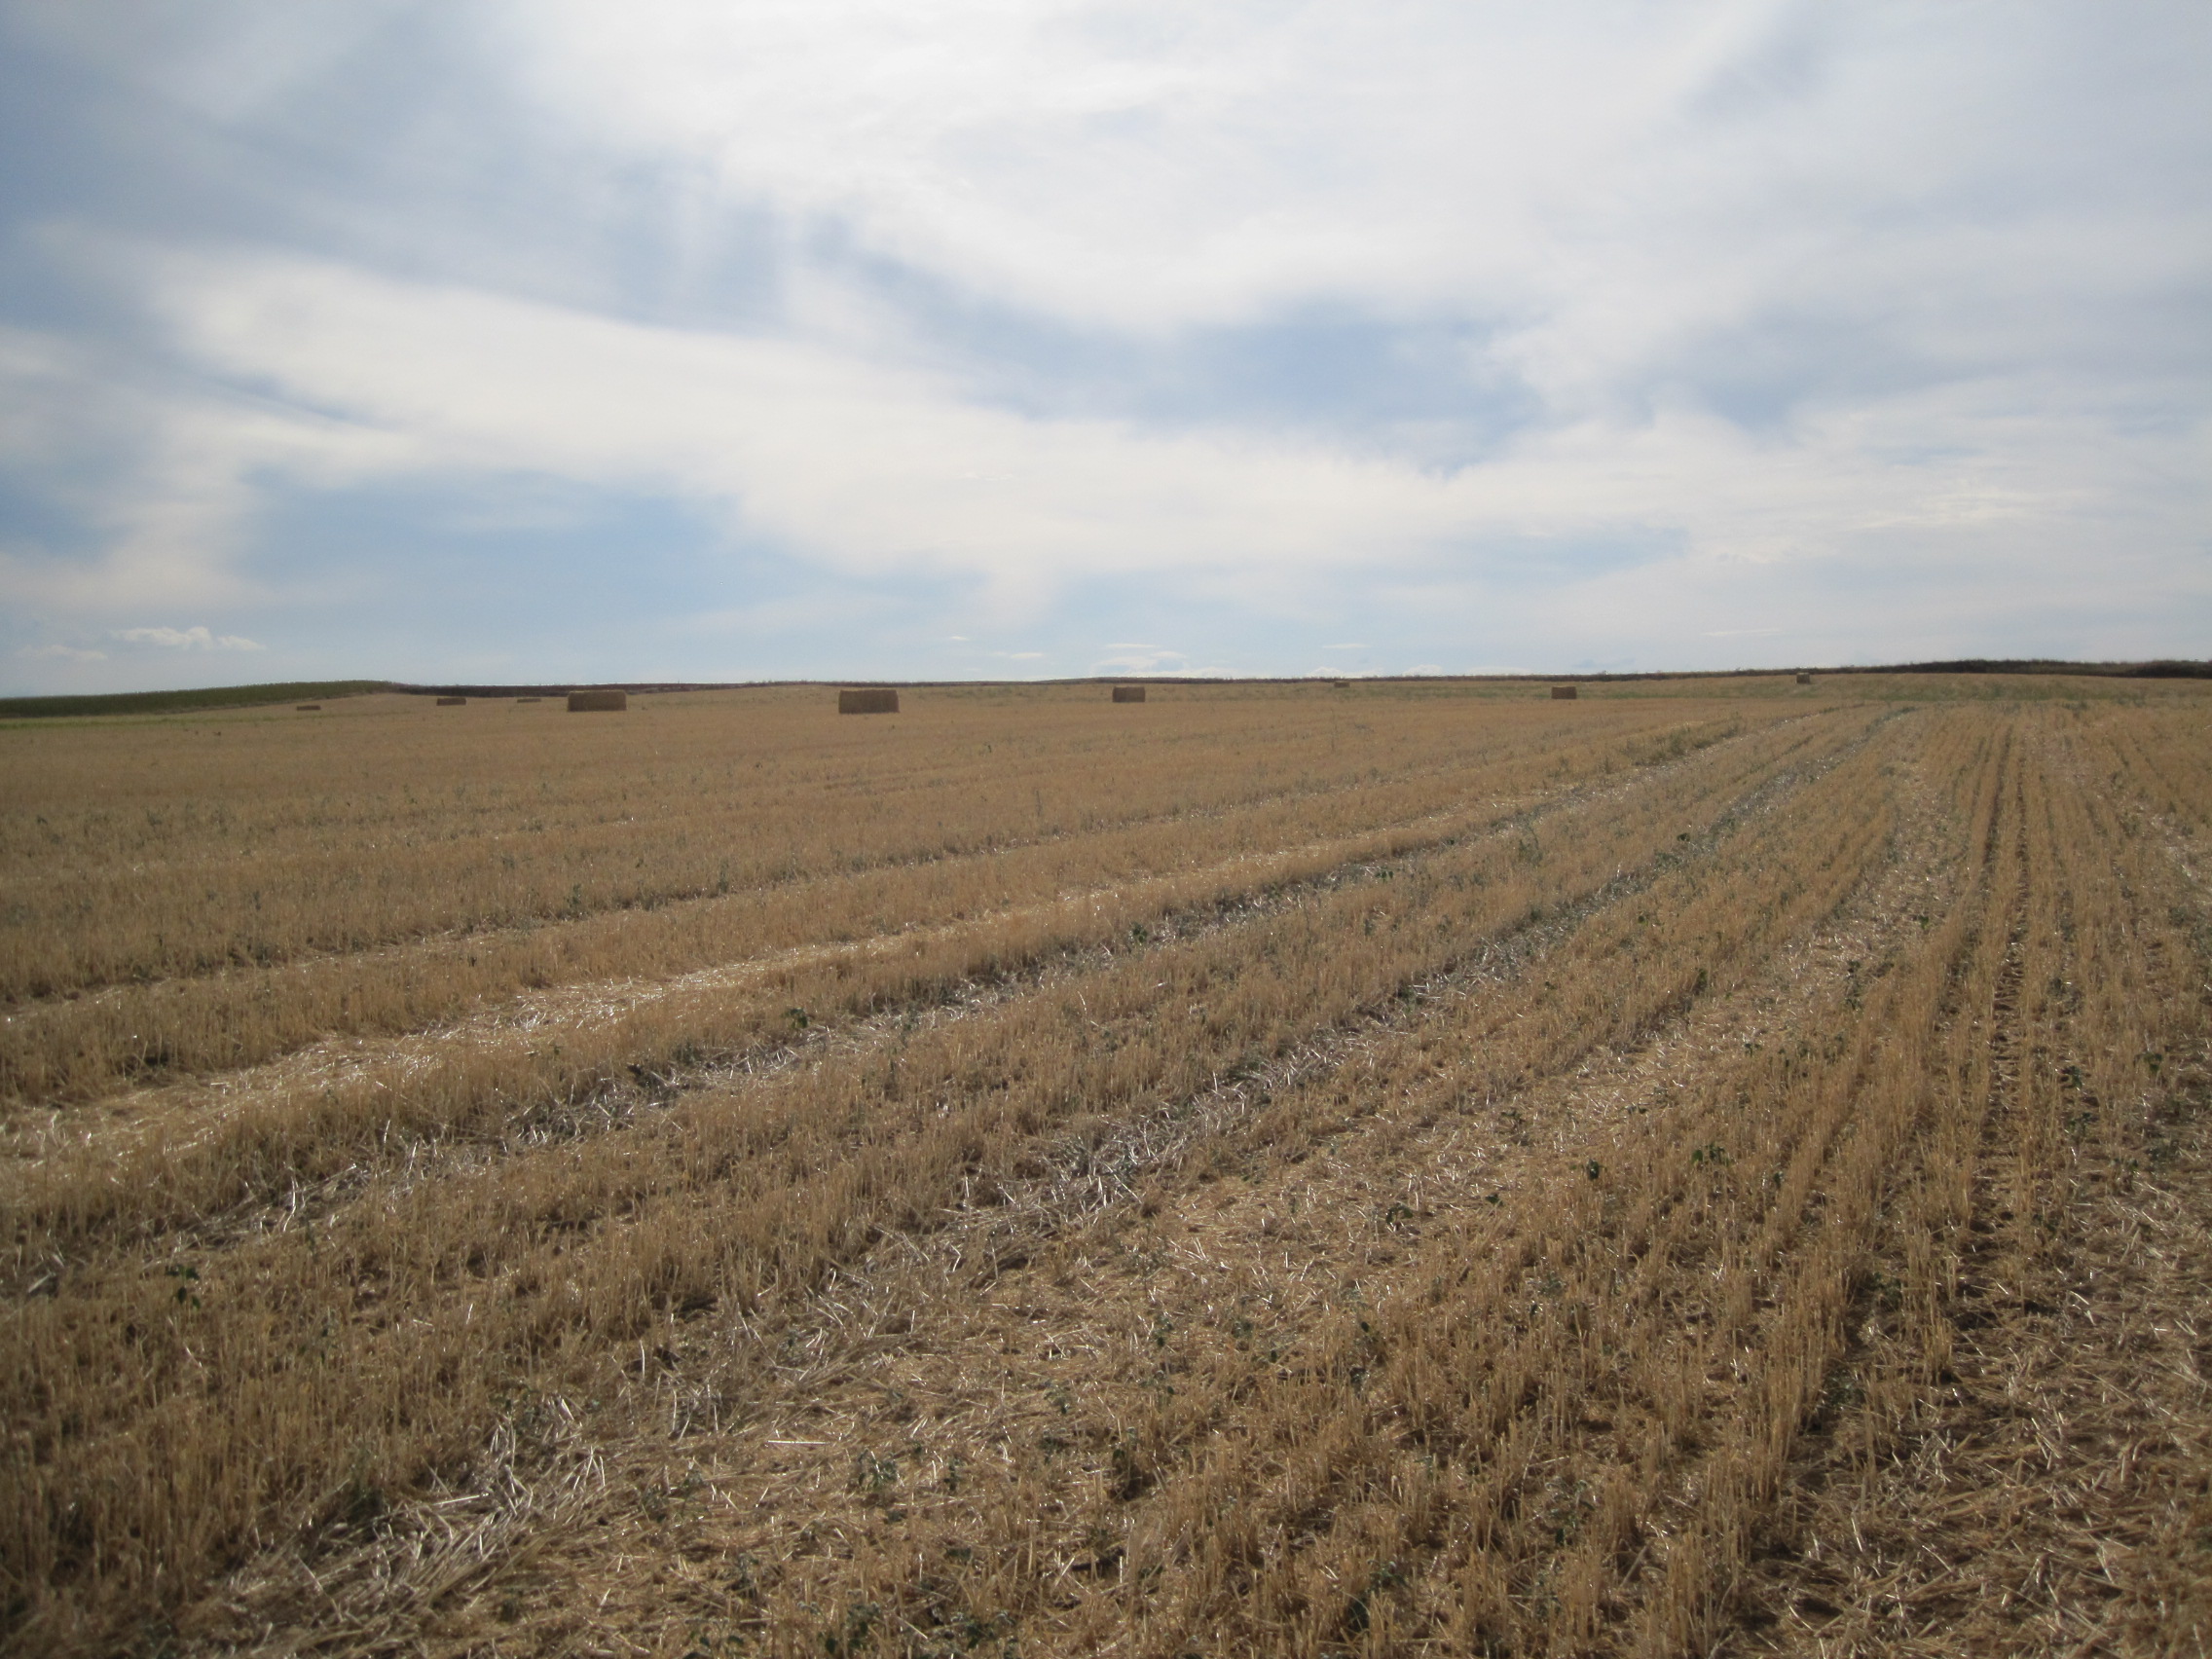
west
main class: Cropland
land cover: Common wheat
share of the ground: < 10 %
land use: Agriculture (excluding fallow land and kitchen gardens)
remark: Harvested field
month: July
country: ES
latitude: 41.9507
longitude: -5.2463
